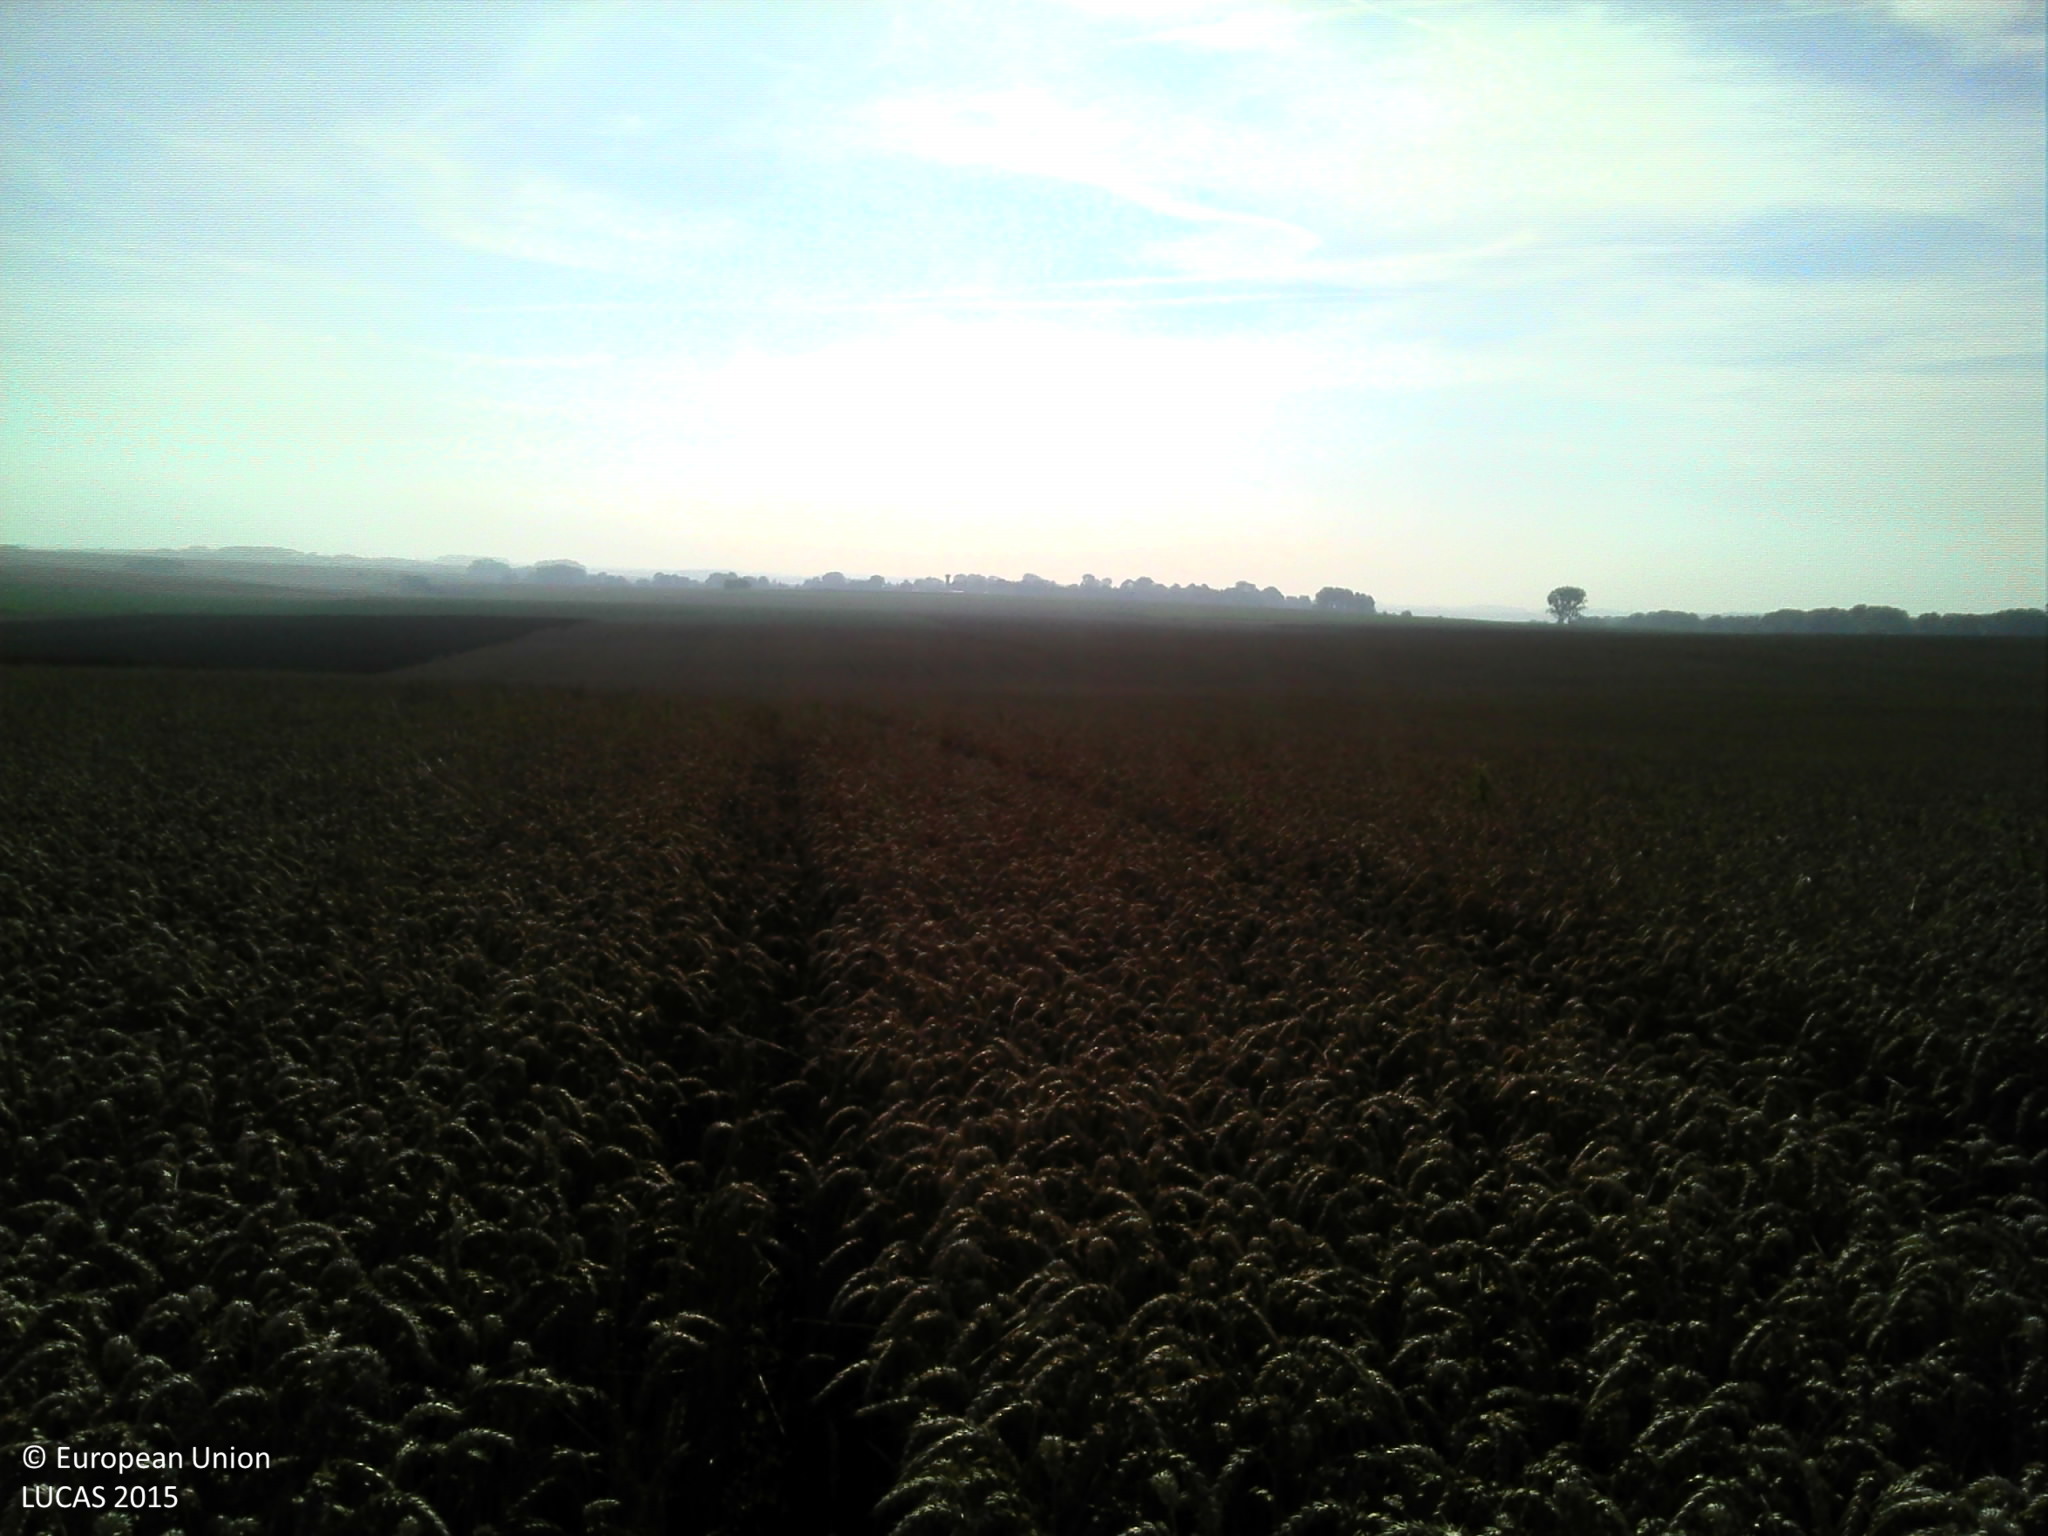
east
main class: Cropland
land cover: Common wheat
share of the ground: > 75 %
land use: Agriculture (excluding fallow land and kitchen gardens)
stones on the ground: < 10 %
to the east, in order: Common wheat
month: July
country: FR
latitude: 50.0551
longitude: 2.3747
